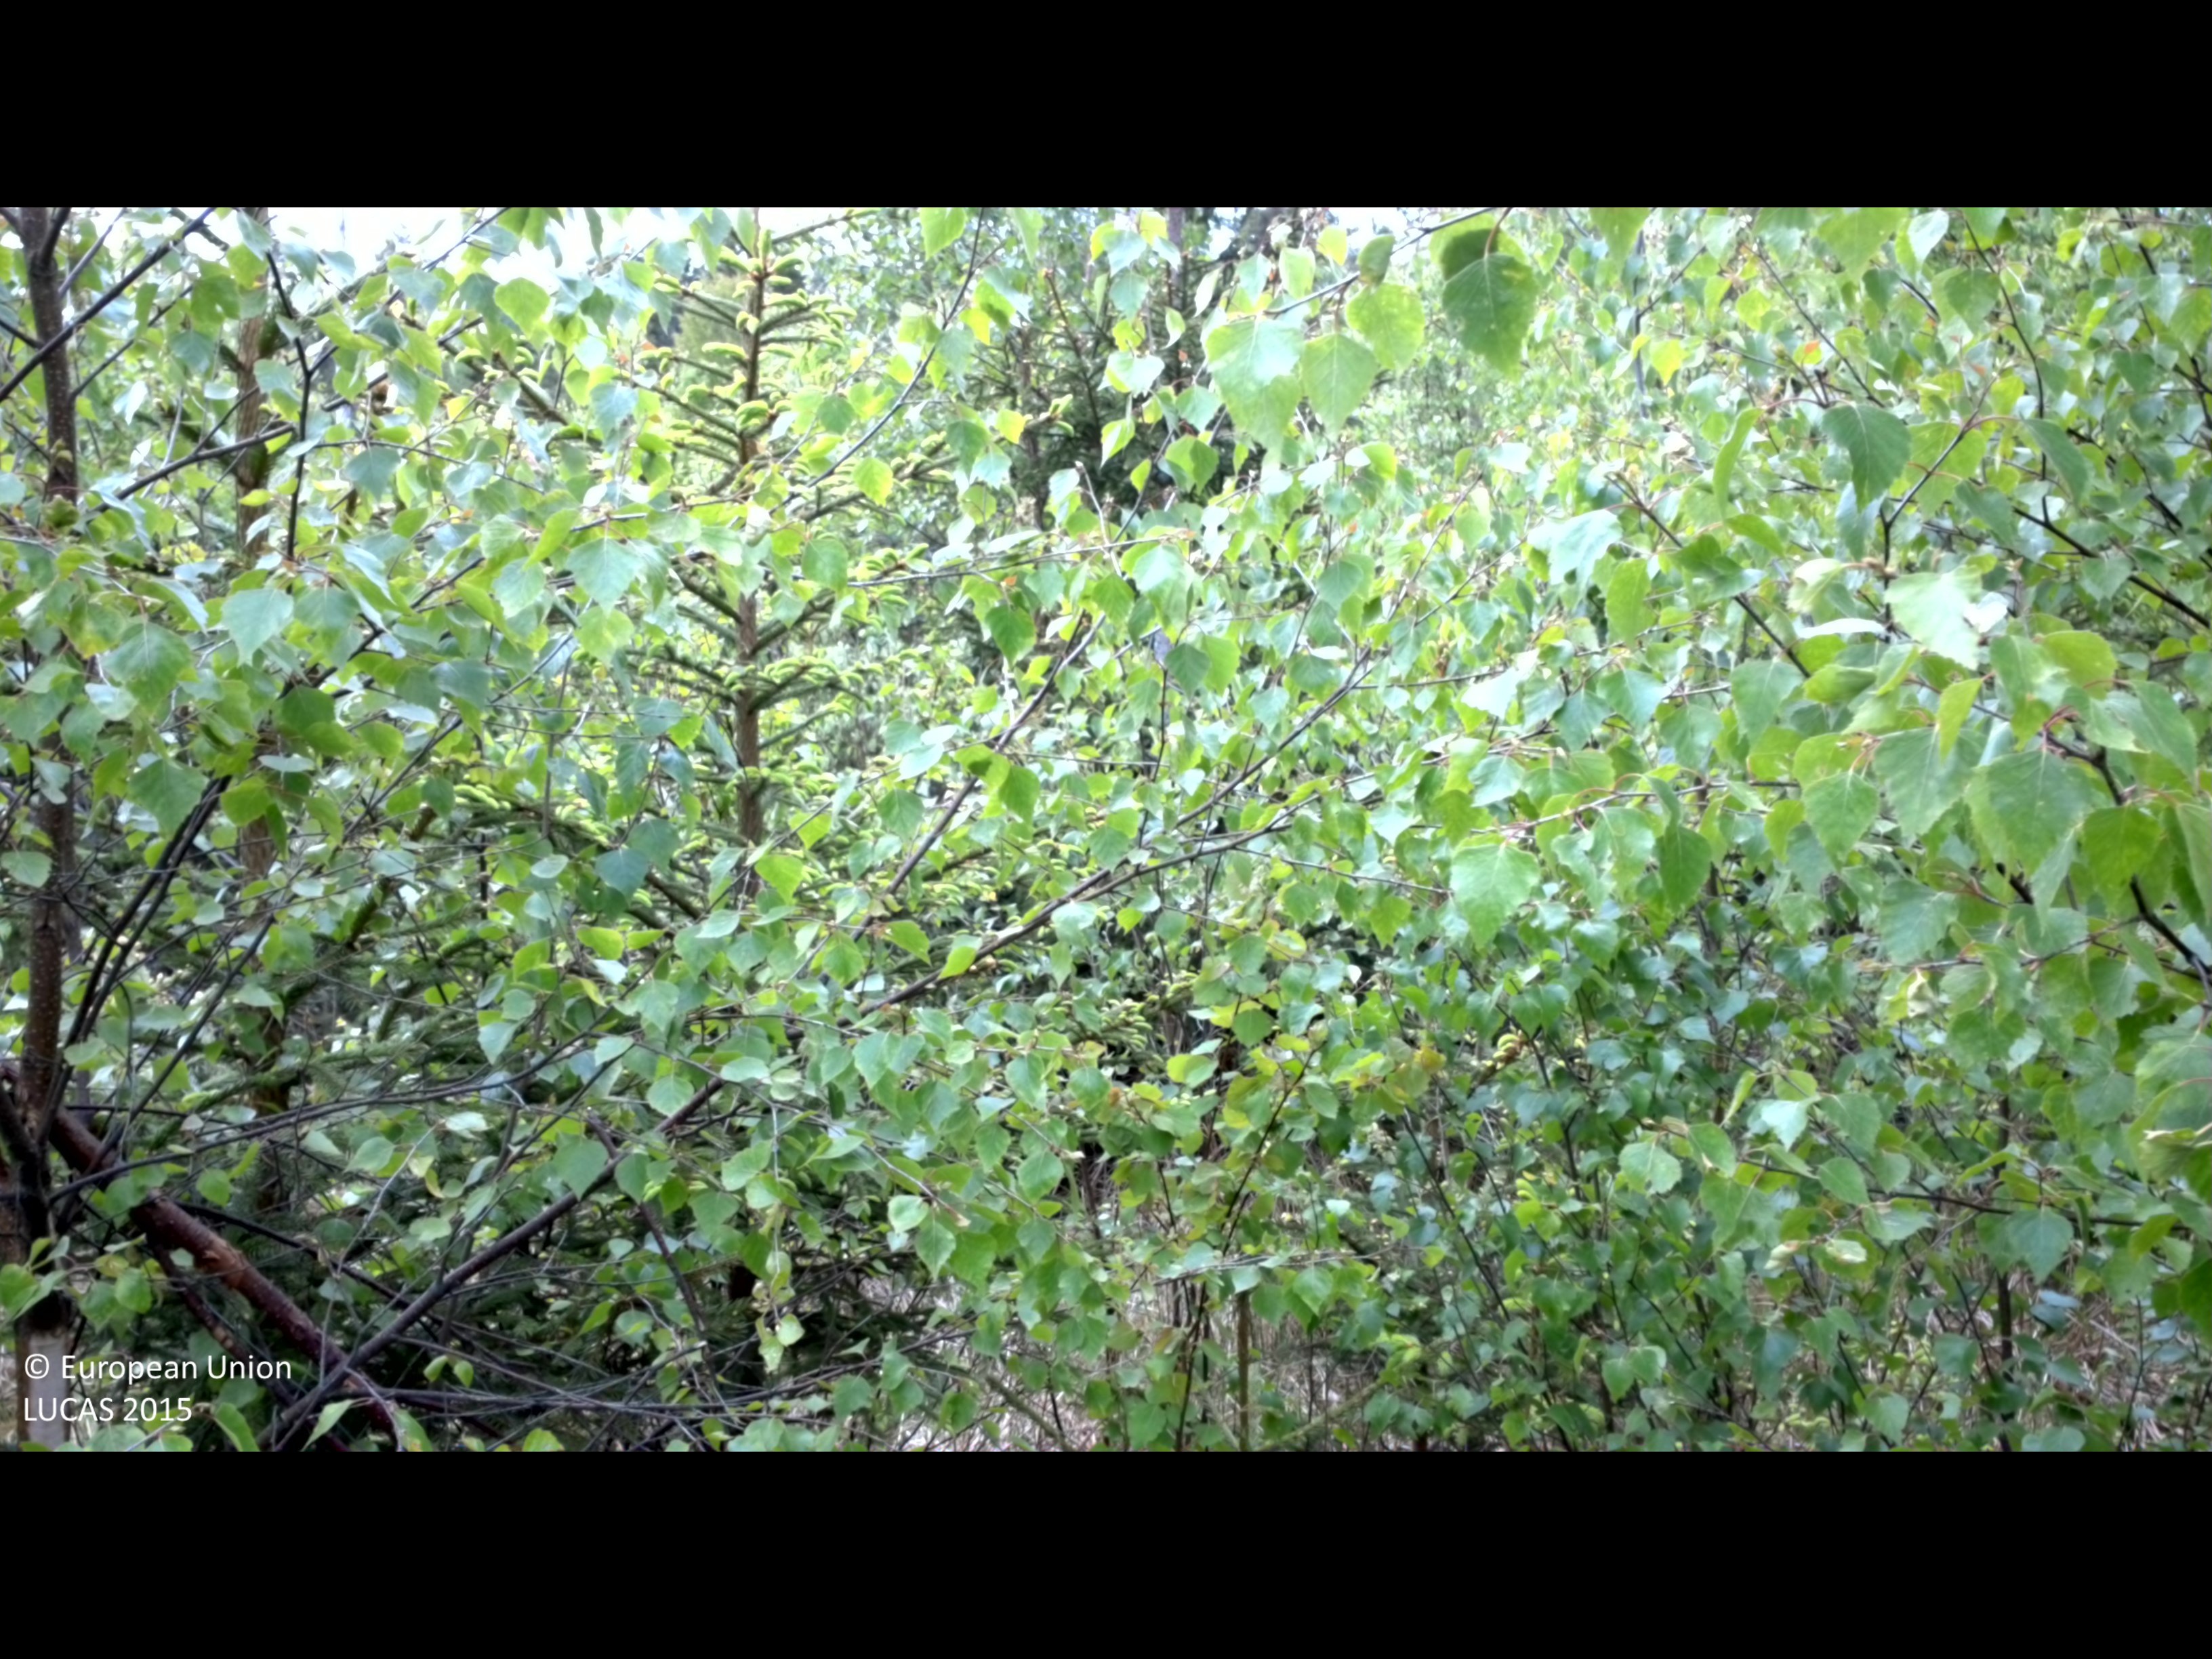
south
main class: Woodland
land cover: Broadleaved woodland
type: boreal forest
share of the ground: 50 - 75 %
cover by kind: broadleaved forest trees 60 %, coniferous forest trees 15 %, shrubs 10 %, herbaceous plants 10 %, lichens and mosses 5 %
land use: Forestry
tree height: < 5 m
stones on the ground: < 10 %
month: May
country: SE
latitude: 57.4657
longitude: 16.5179
